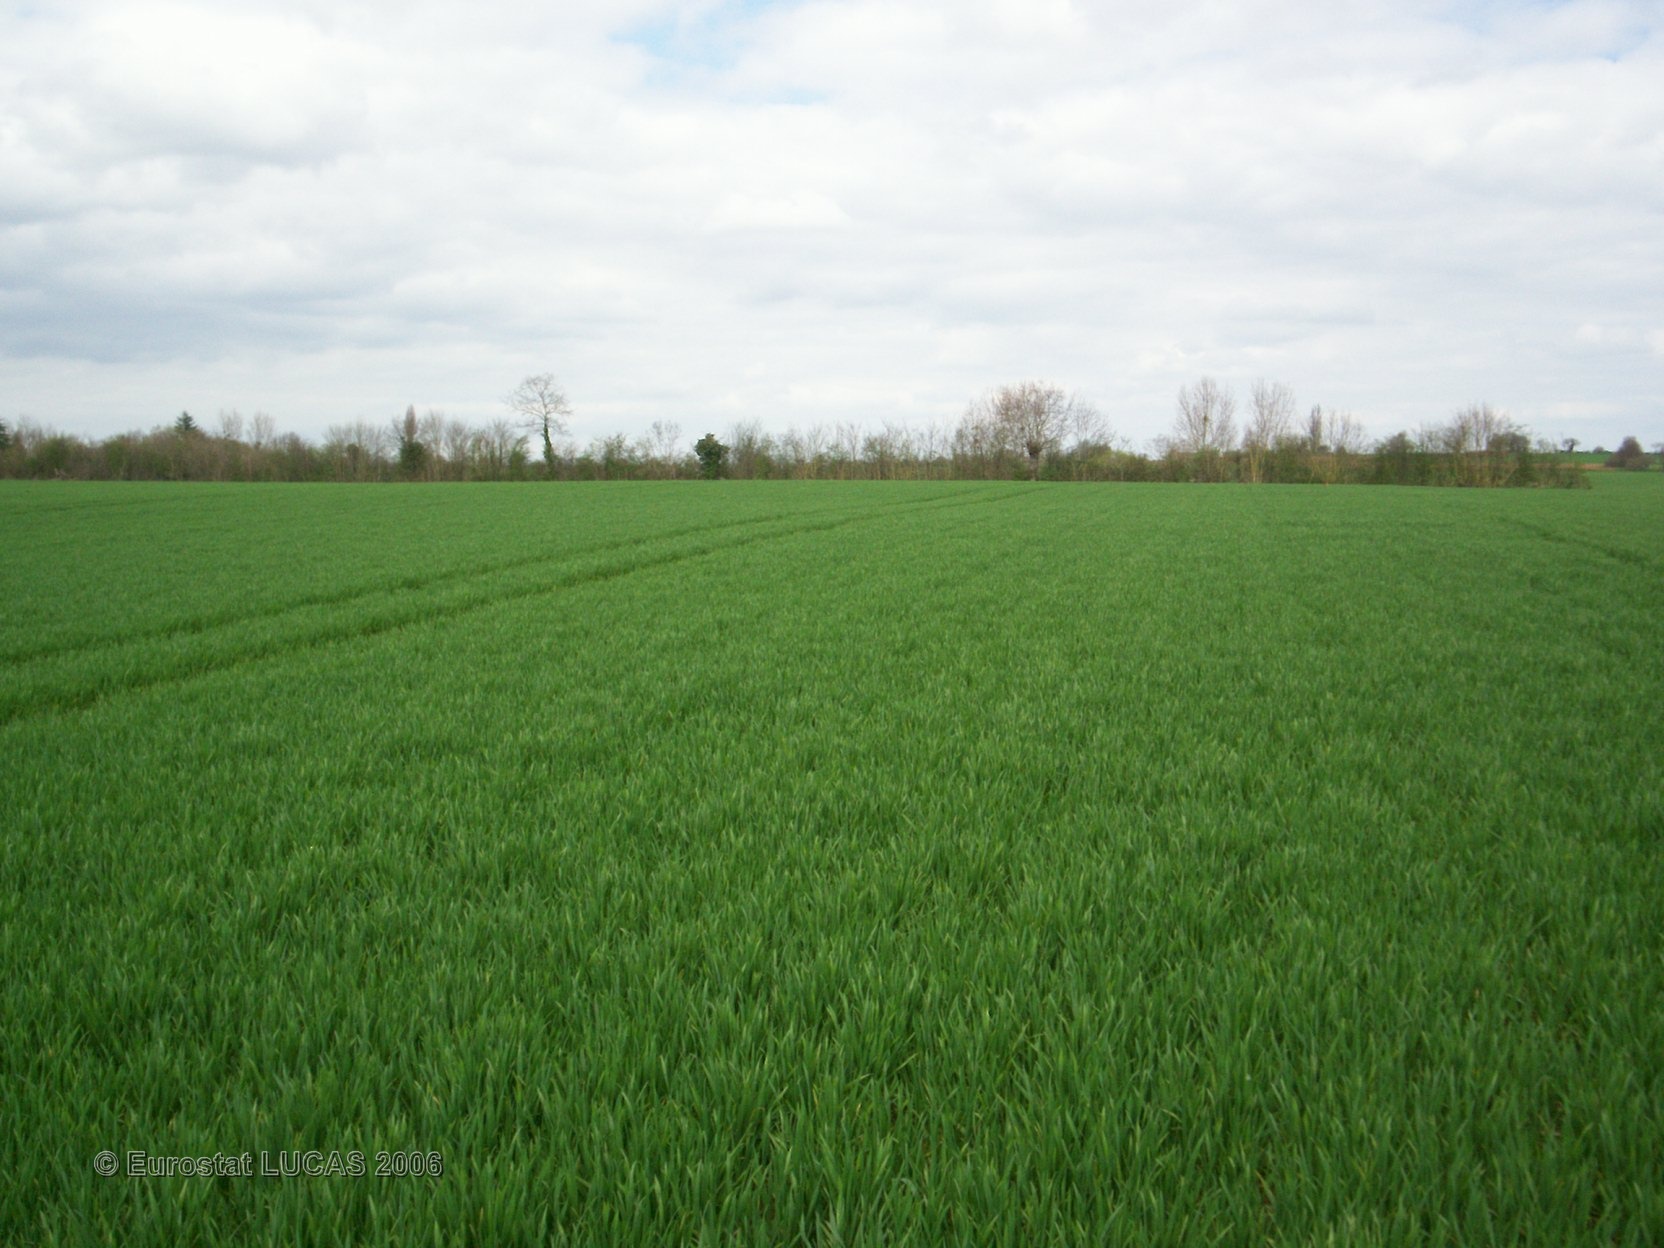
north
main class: Cropland
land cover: Common wheat
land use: Agriculture (excluding fallow land and kitchen gardens)
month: April
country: FR
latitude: 48.3053
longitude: 0.3345
